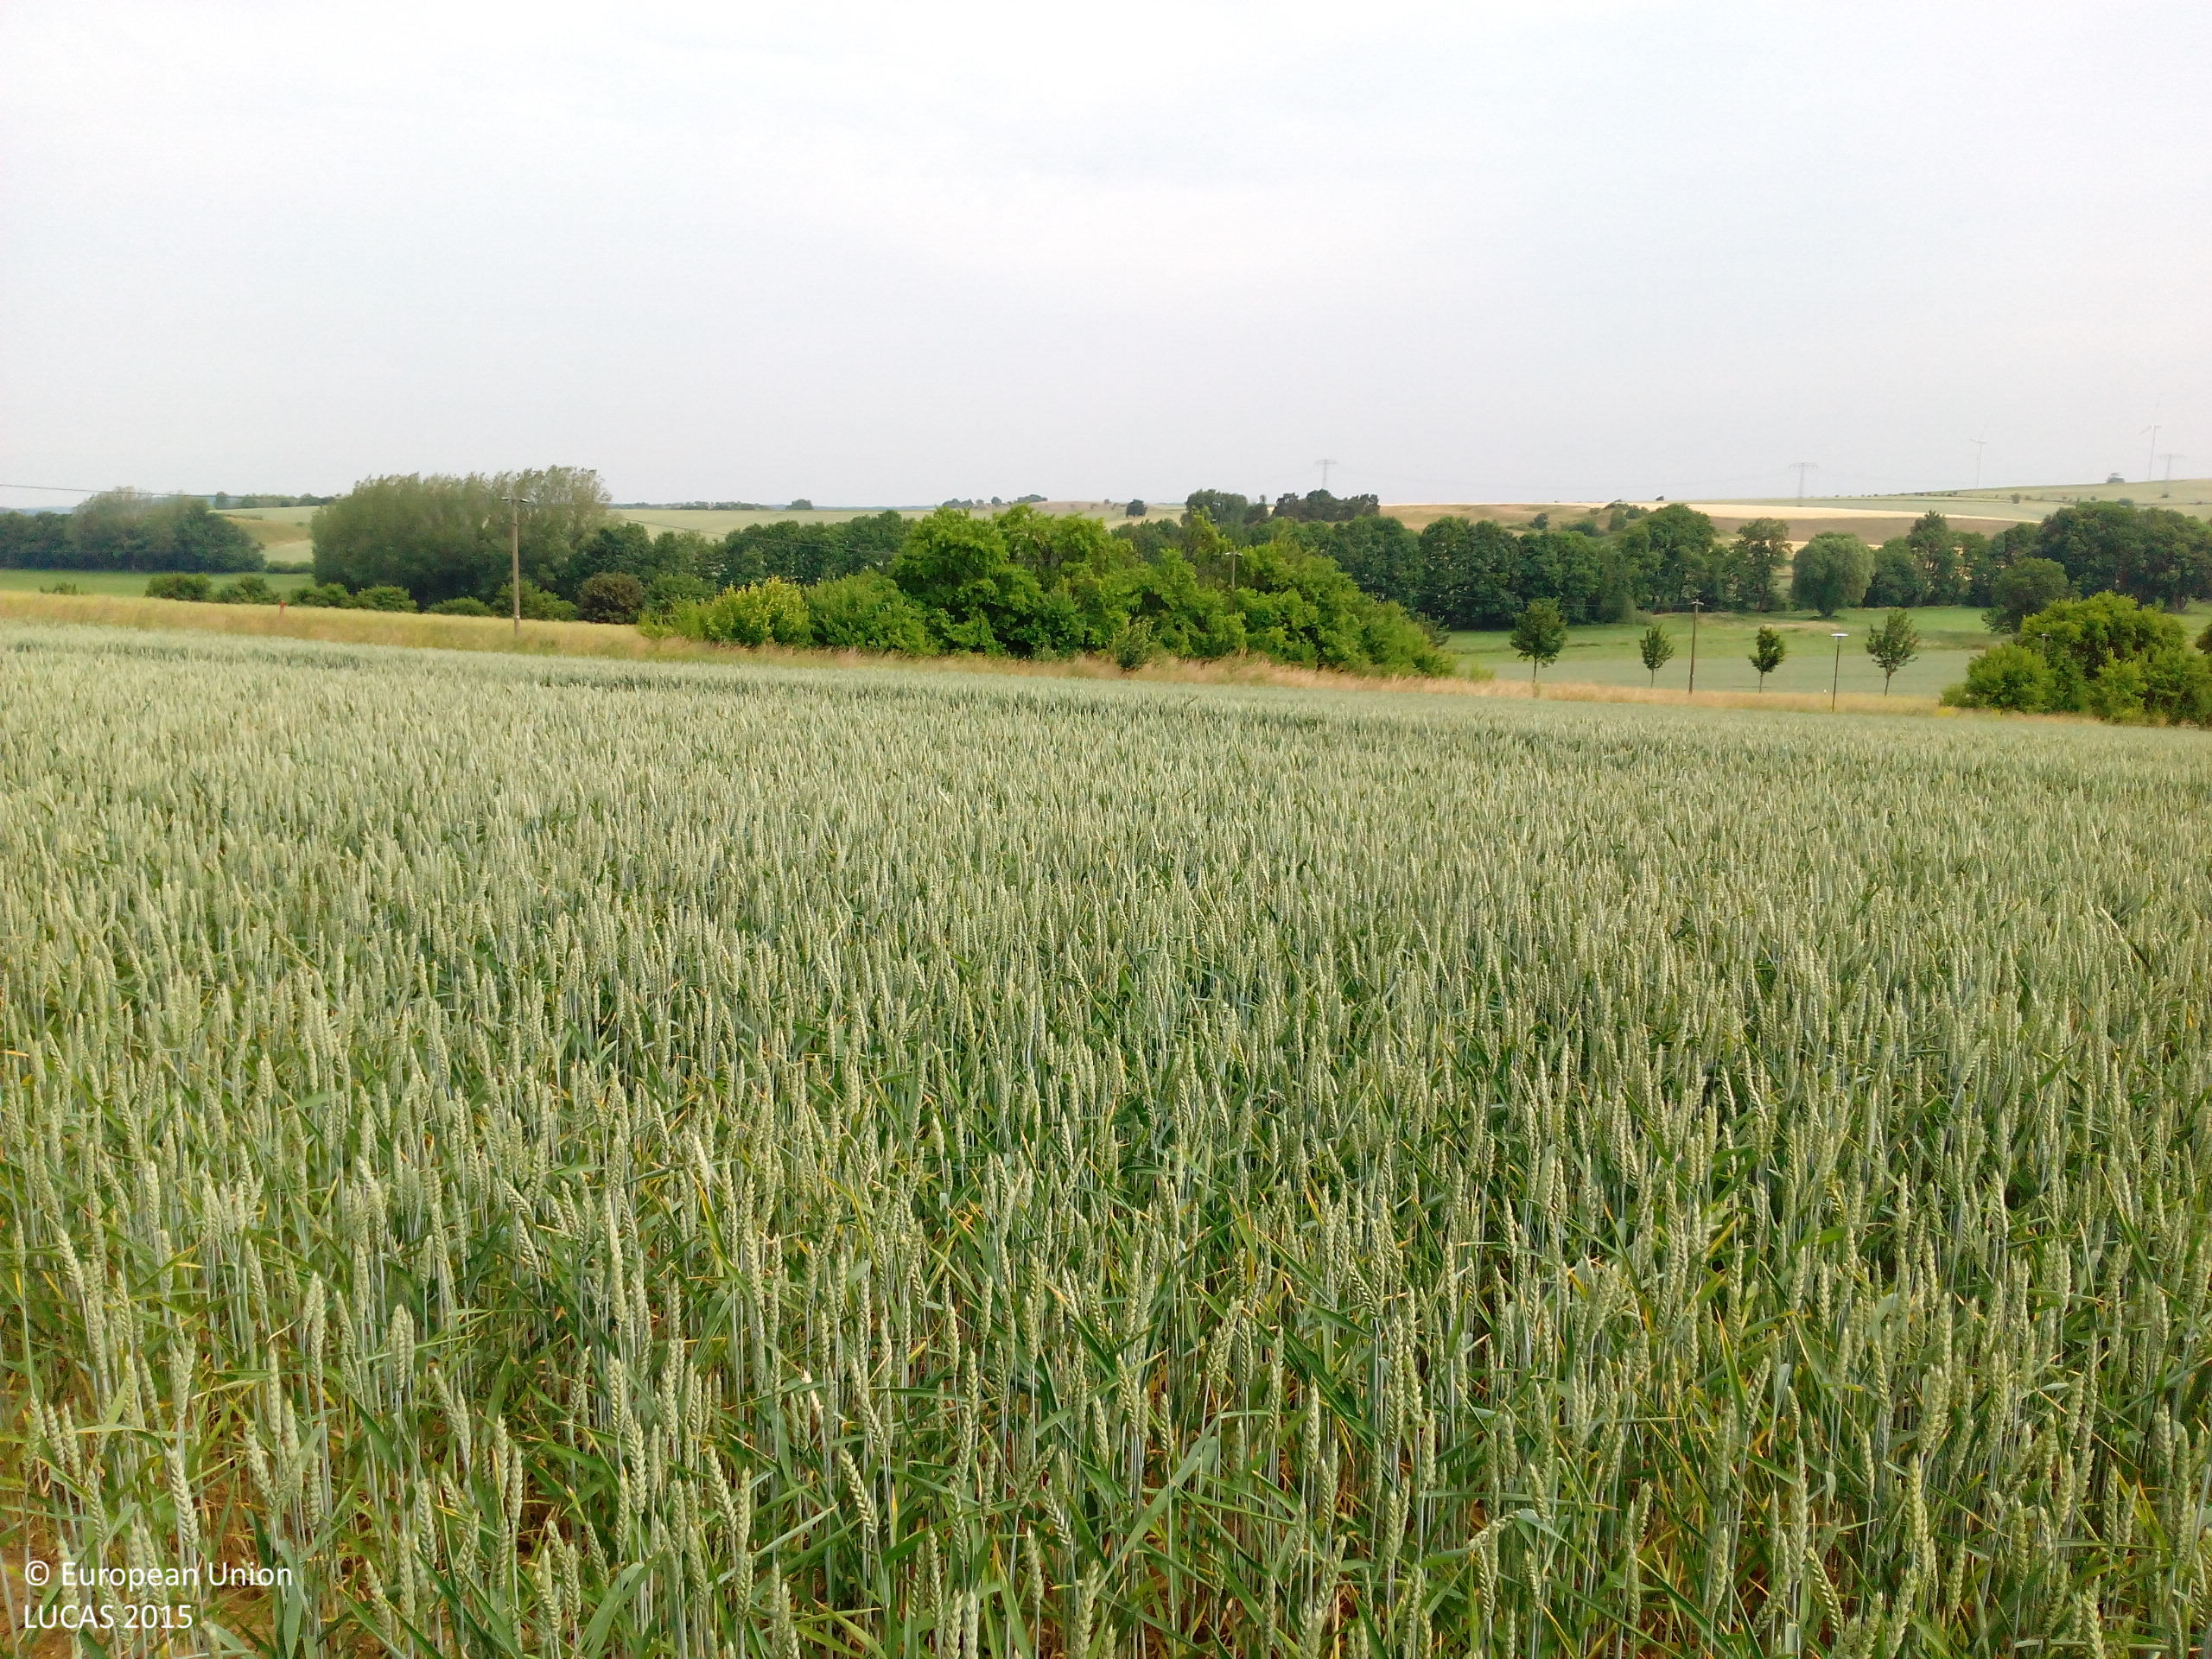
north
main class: Woodland
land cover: Broadleaved woodland
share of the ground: > 75 %
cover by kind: broadleaved forest trees 100 %
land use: Forestry
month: June
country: DE
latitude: 52.2103
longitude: 11.1265
